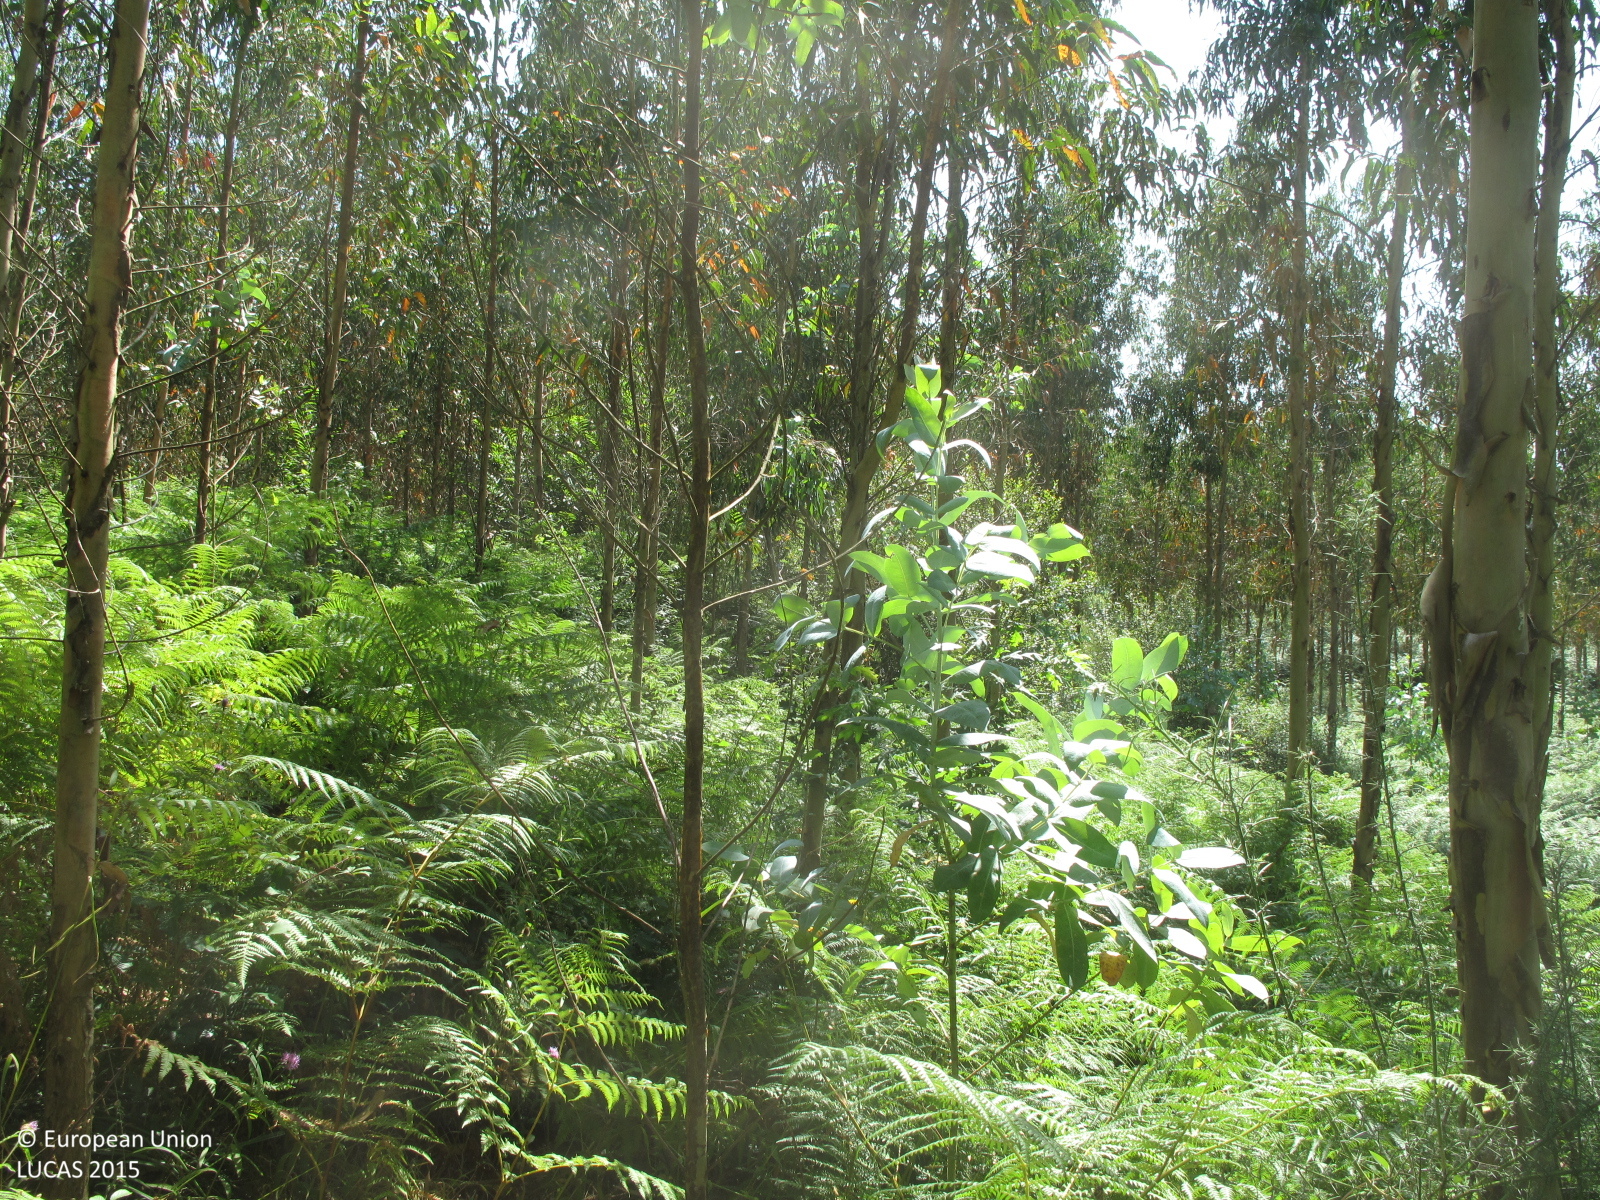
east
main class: Woodland
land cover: Broadleaved woodland
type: exotic forest
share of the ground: 50 - 75 %
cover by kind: broadleaved forest trees 50 %, herbaceous plants 30 %, shrubs 20 %
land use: Forestry
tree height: > 5 m
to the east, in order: Broadleaved woodland
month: July
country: ES
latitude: 43.2865
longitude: -8.2546
